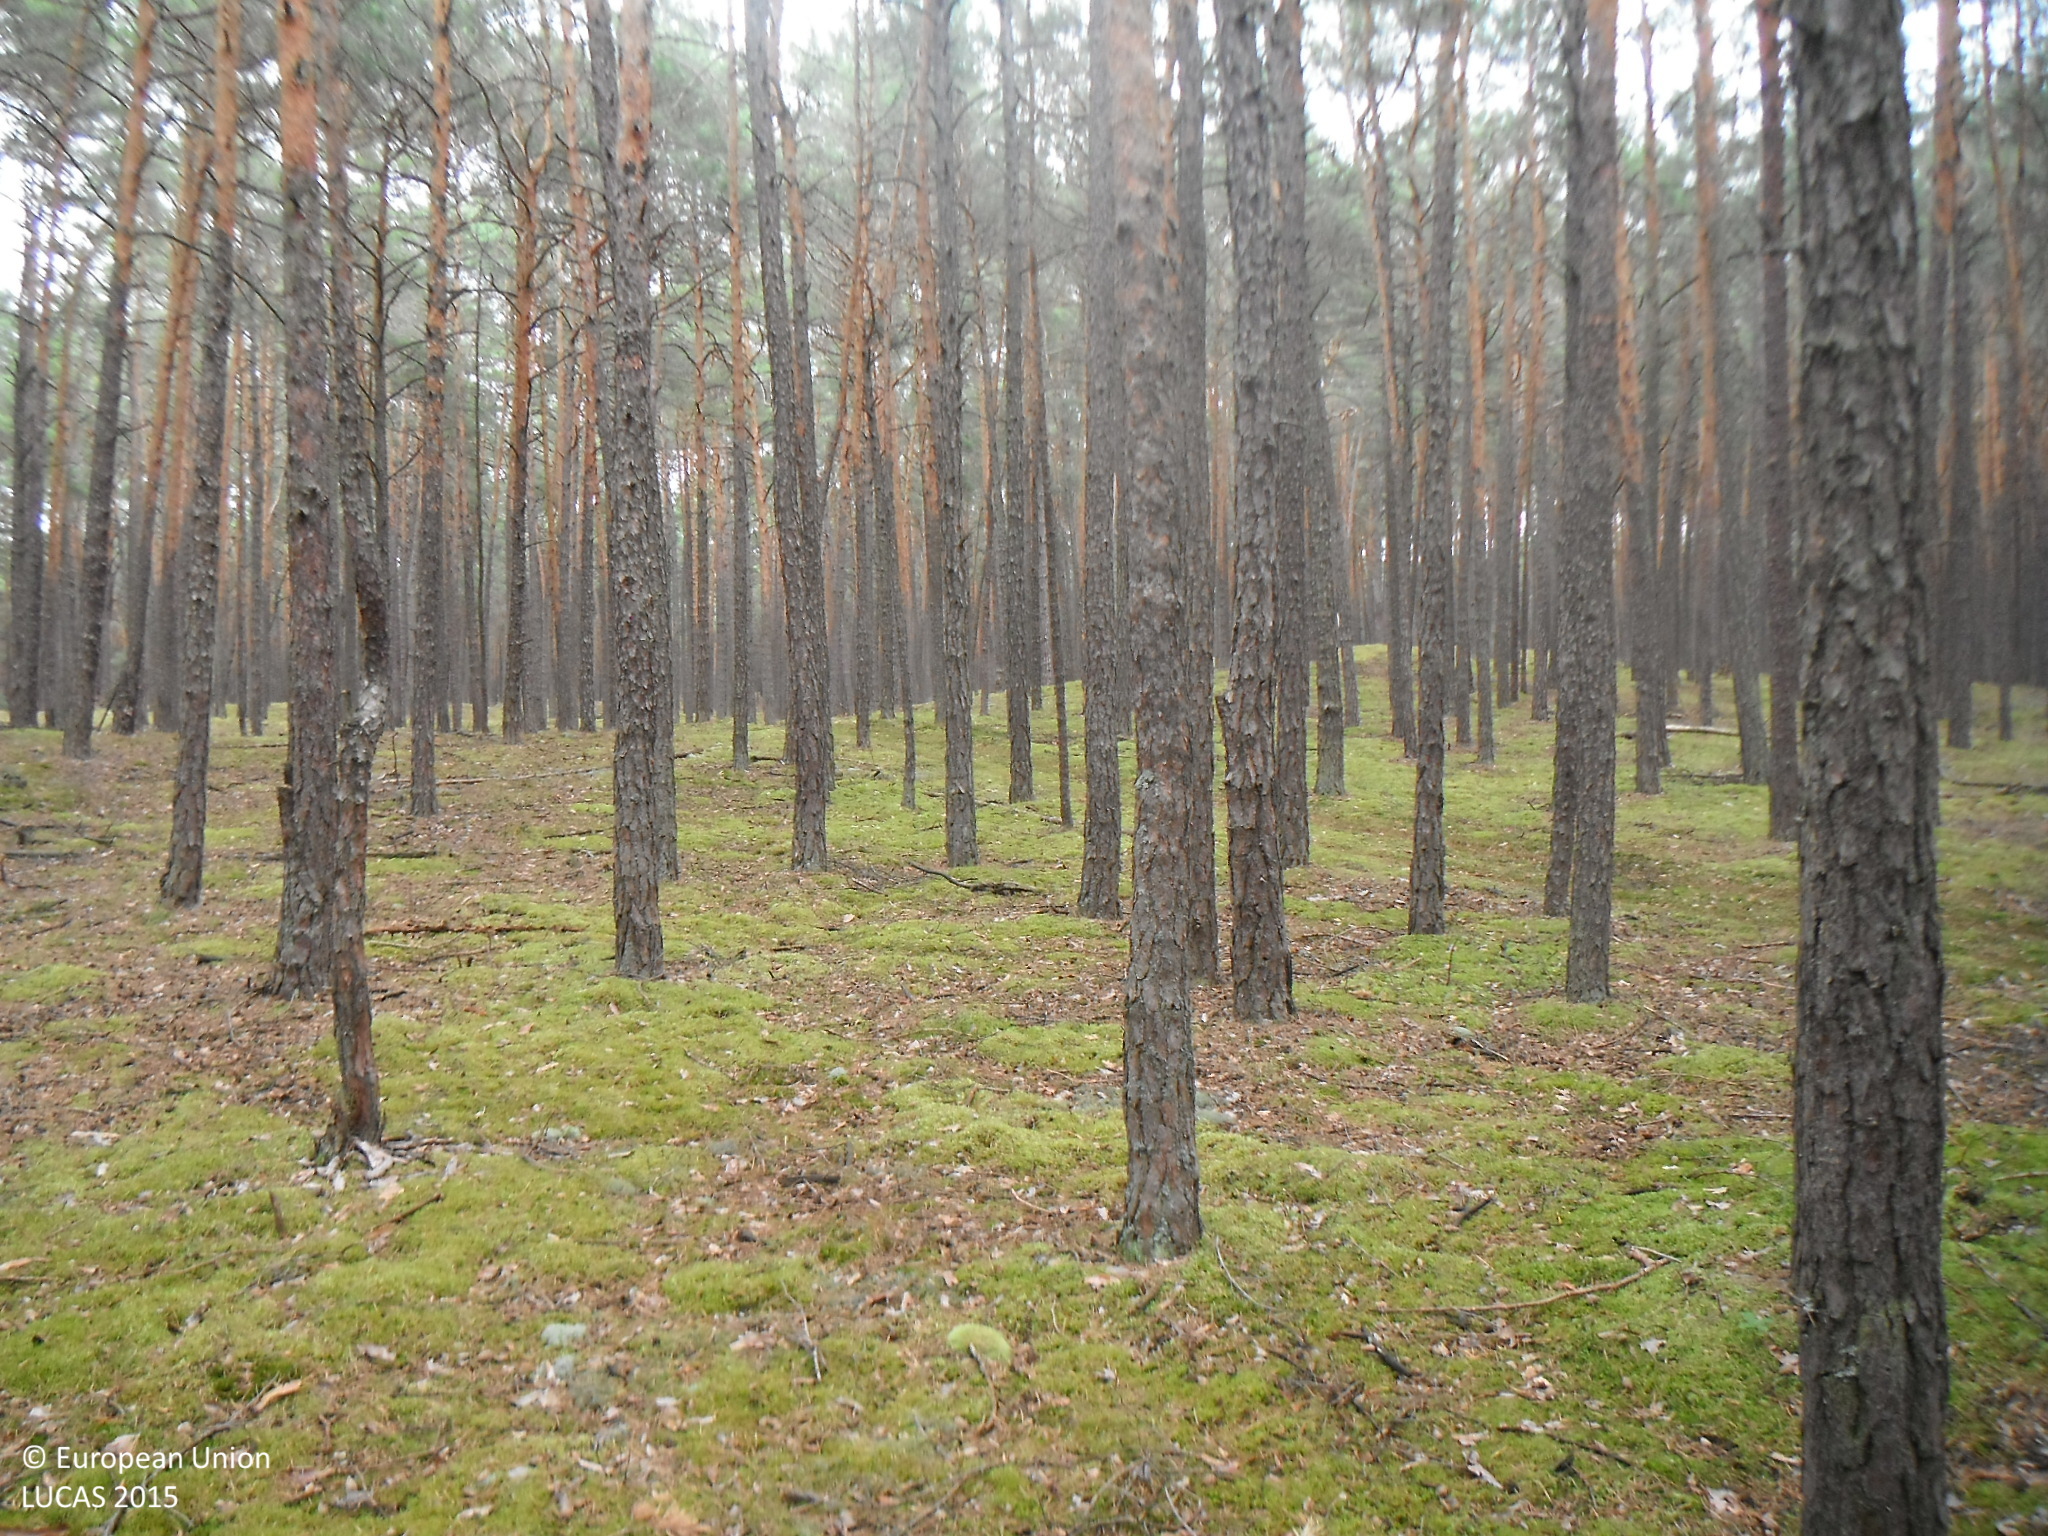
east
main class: Woodland
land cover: Pine dominated coniferous woodland
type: hemiboreal forest and nemoral coniferous forest and mixed broadleaved-coniferous forest
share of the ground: > 75 %
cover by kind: coniferous forest trees 80 %, lichens and mosses 20 %
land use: Forestry
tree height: > 5 m
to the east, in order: Pine dominated coniferous woodland; Tracks; Pine dominated coniferous woodland; Tracks; Pine dominated coniferous woodland
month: June
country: SK
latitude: 48.6355
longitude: 17.2423
